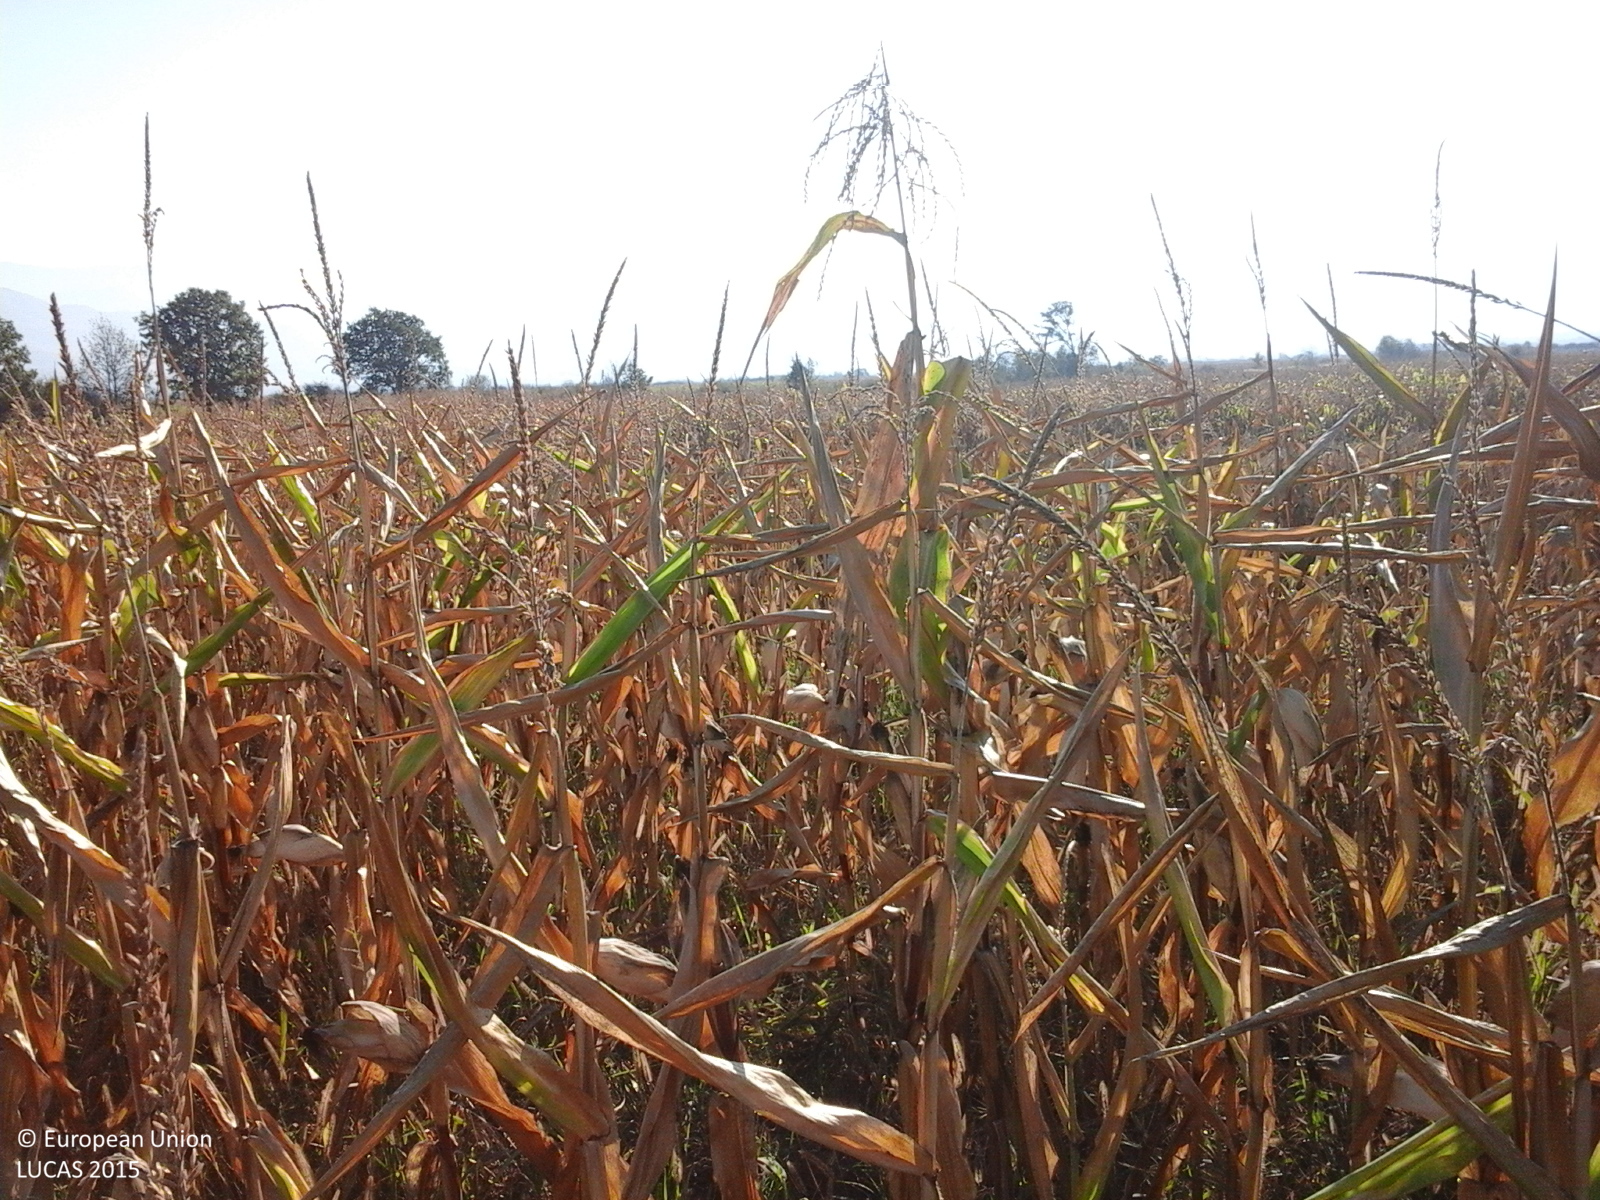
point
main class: Cropland
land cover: Maize
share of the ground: > 75 %
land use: Agriculture (excluding fallow land and kitchen gardens)
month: September
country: RO
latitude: 46.6022
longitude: 22.4666
